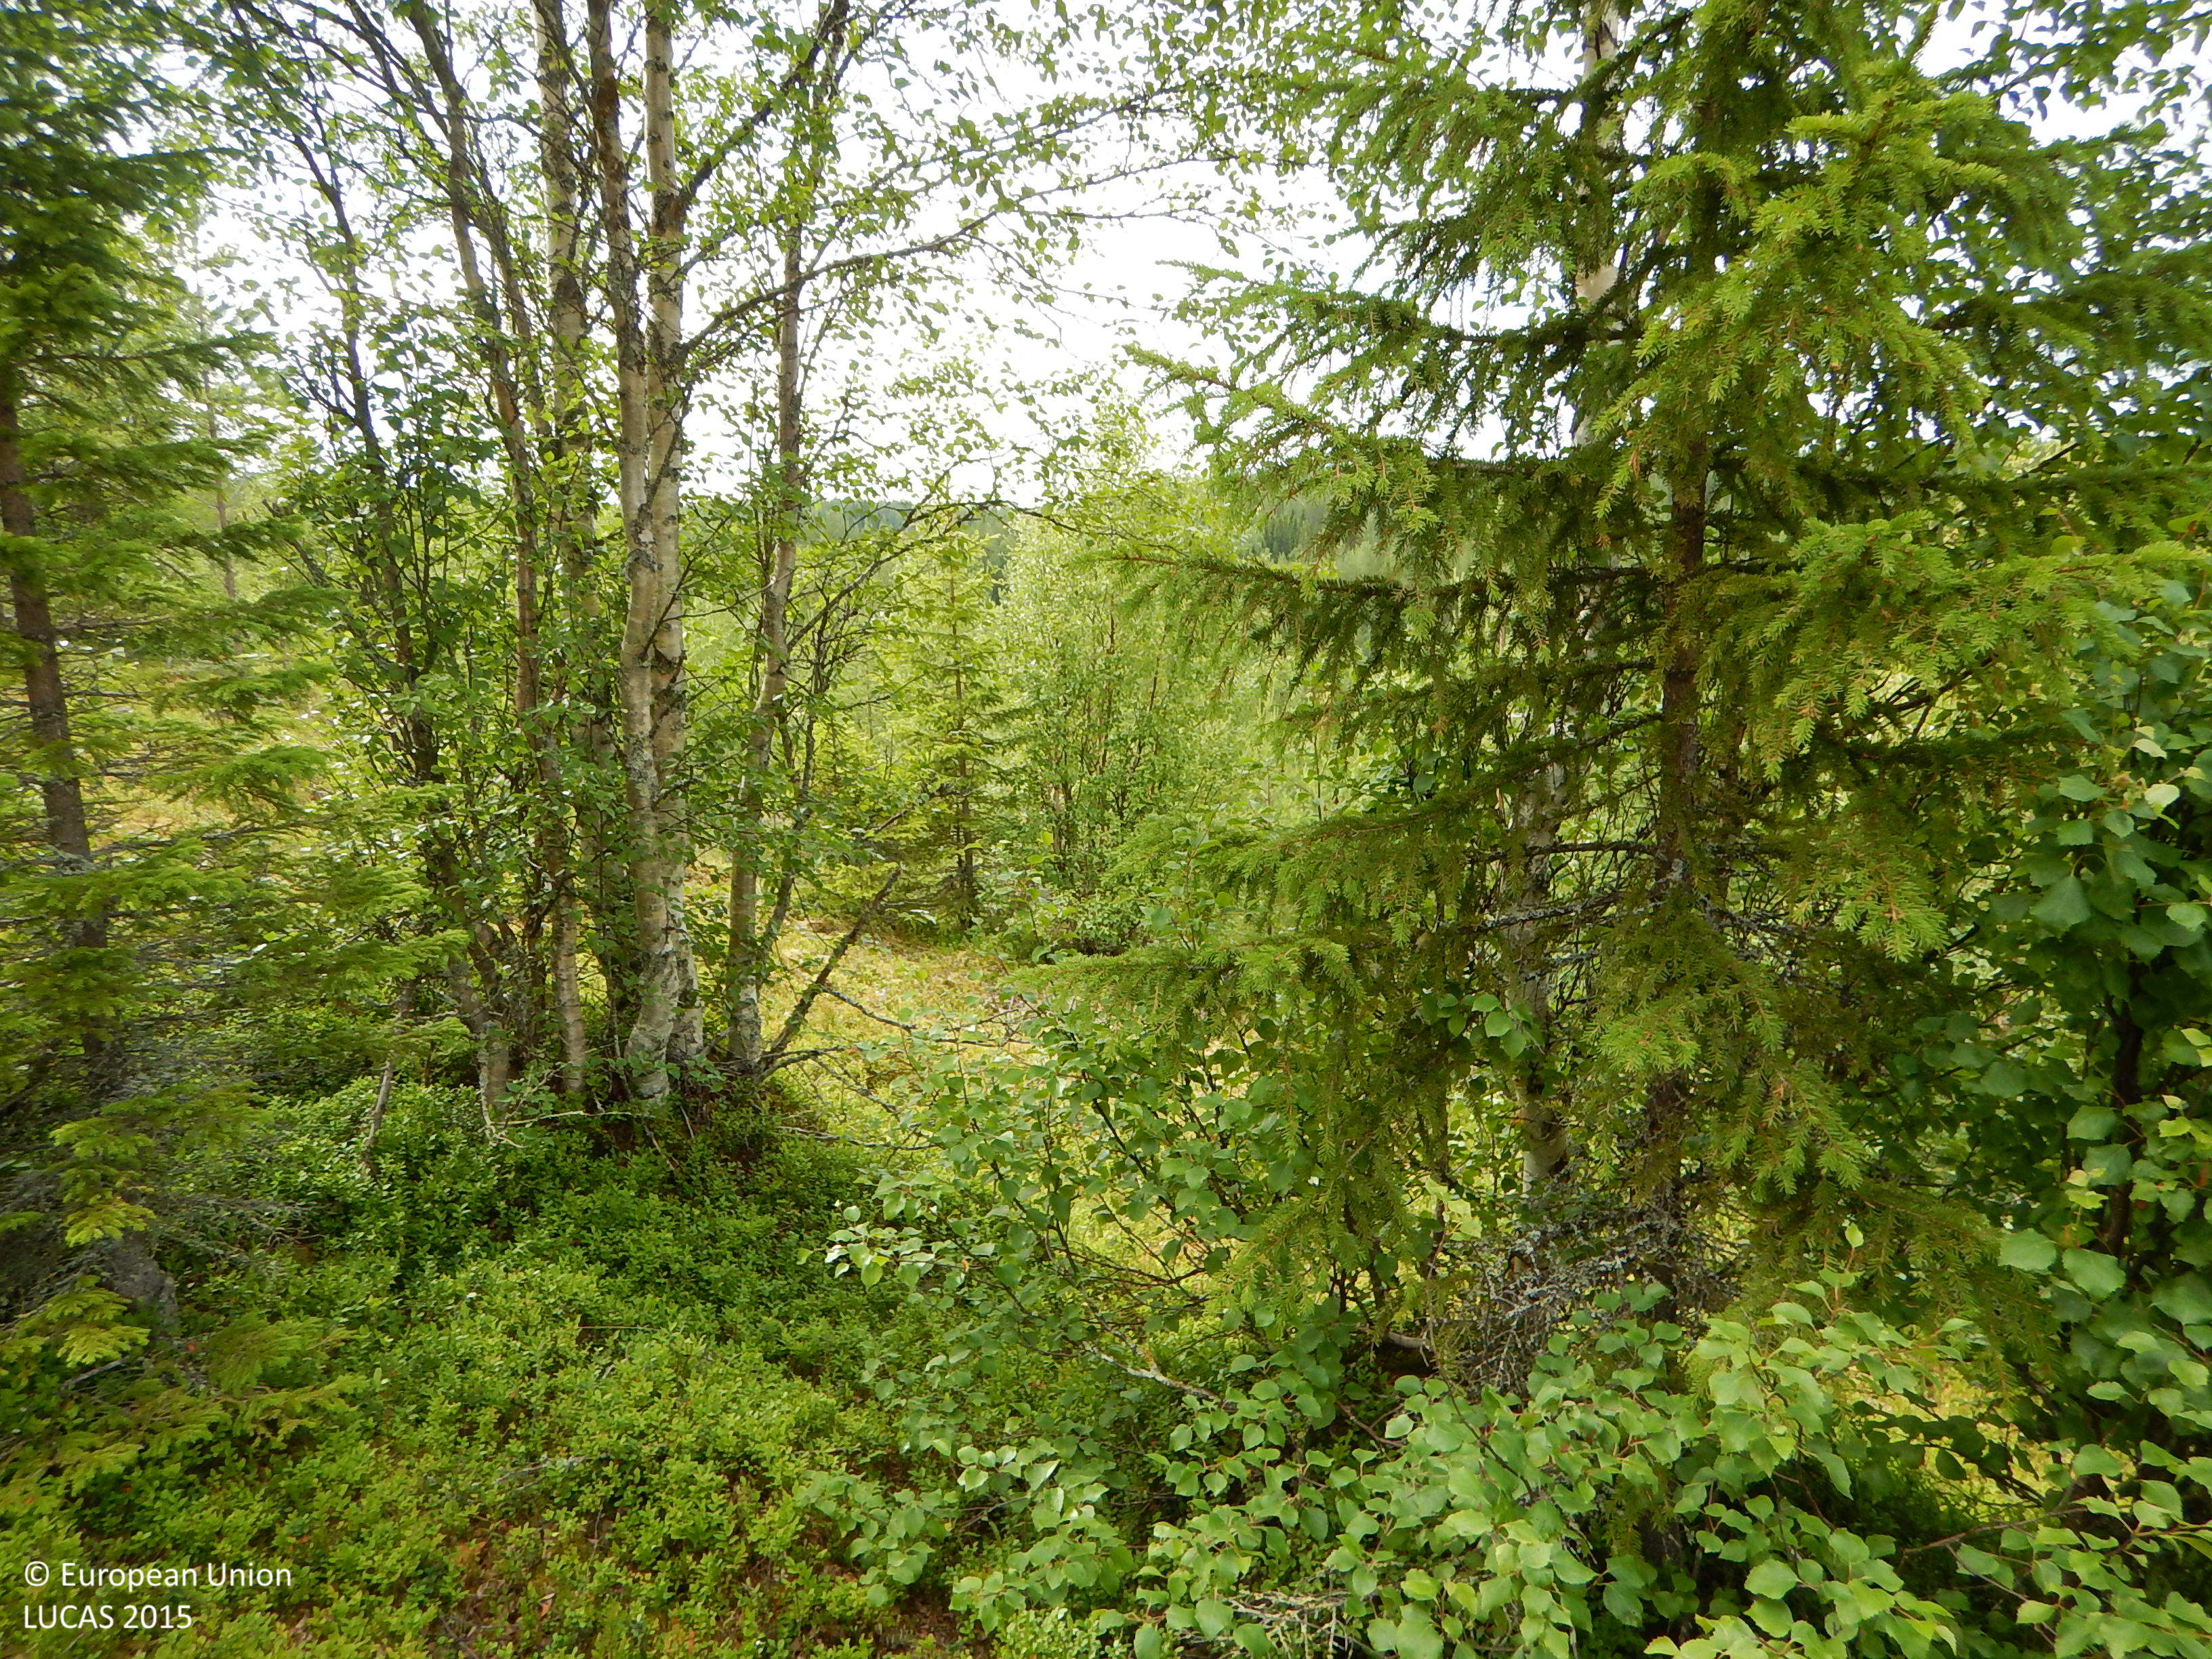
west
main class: Woodland
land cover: Pine dominated mixed woodland
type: boreal forest
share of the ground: 50 - 75 %
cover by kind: coniferous forest trees 35 %, shrubs 20 %, broadleaved forest trees 15 %, herbaceous plants 15 %, lichens and mosses 15 %
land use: Forestry
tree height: < 5 m
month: July
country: SE
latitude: 64.6645
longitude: 20.2999
